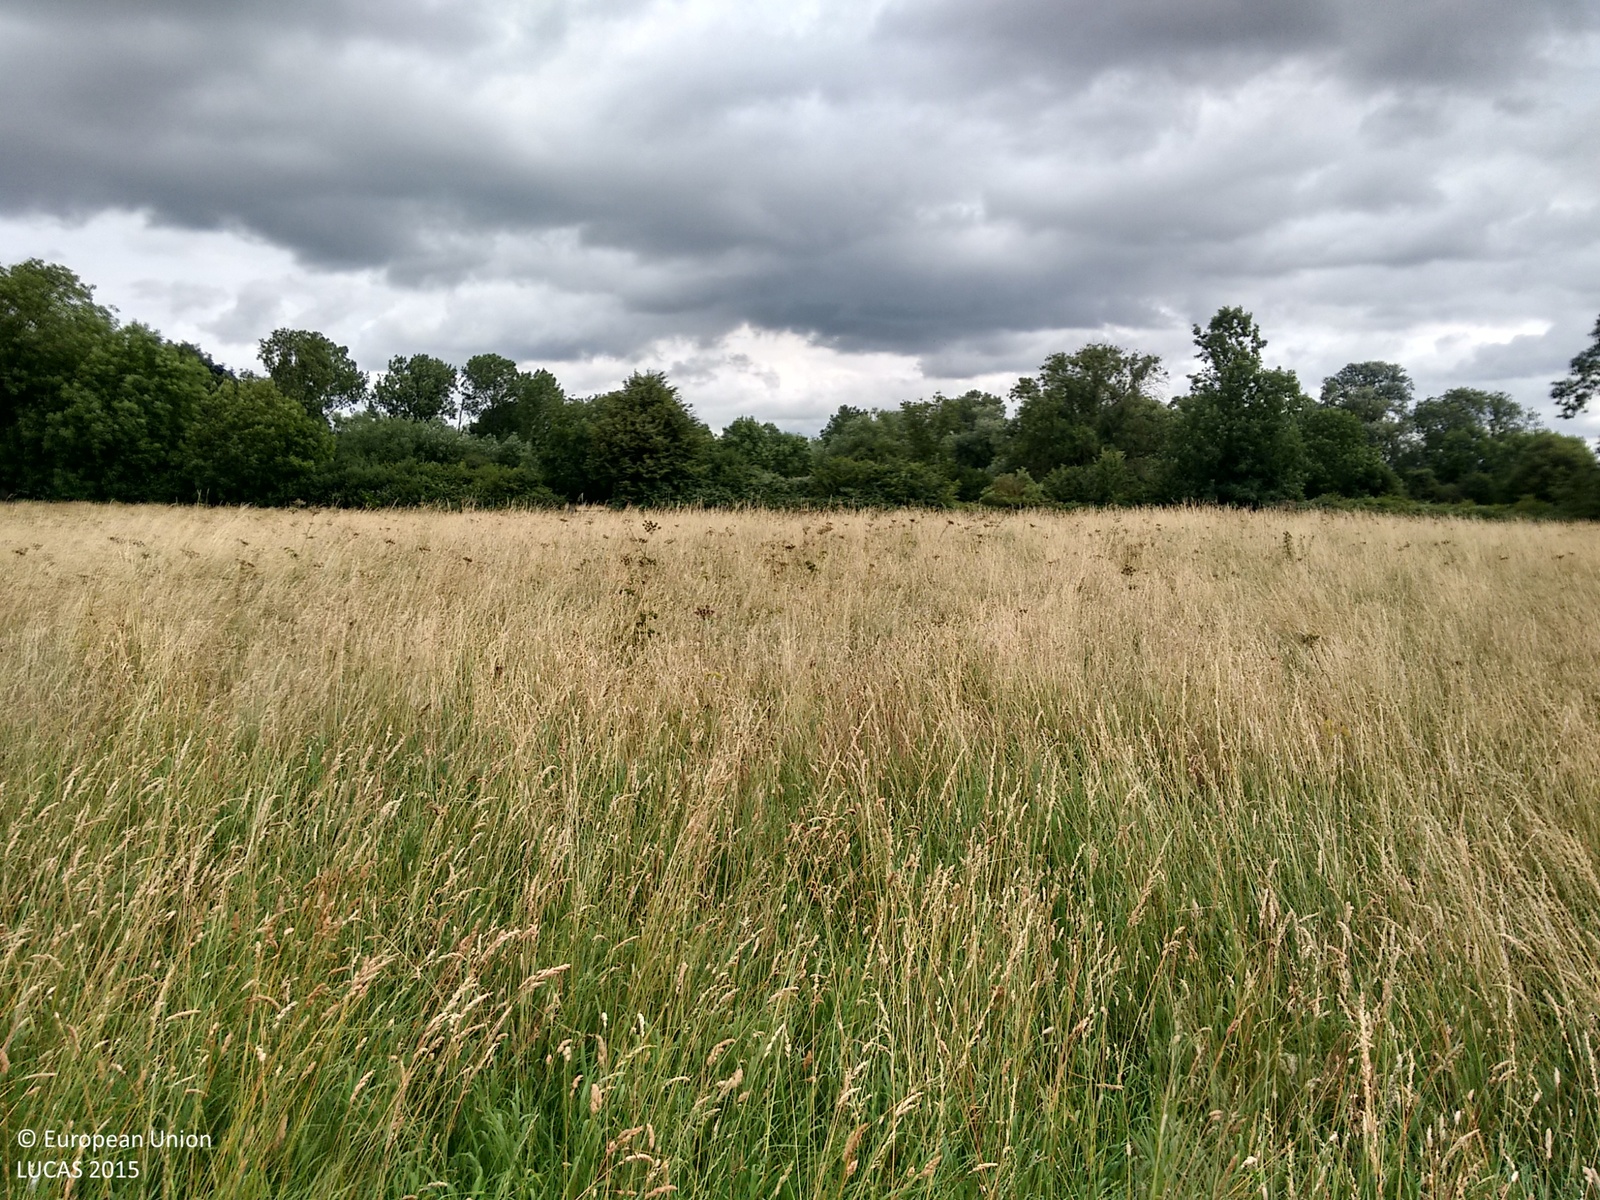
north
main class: Grassland
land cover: Grassland without tree/shrub cover
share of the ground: > 75 %
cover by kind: herbaceous plants 100 %
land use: Agriculture (excluding fallow land and kitchen gardens)
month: July
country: GB
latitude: 53.0572
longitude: -0.8593
